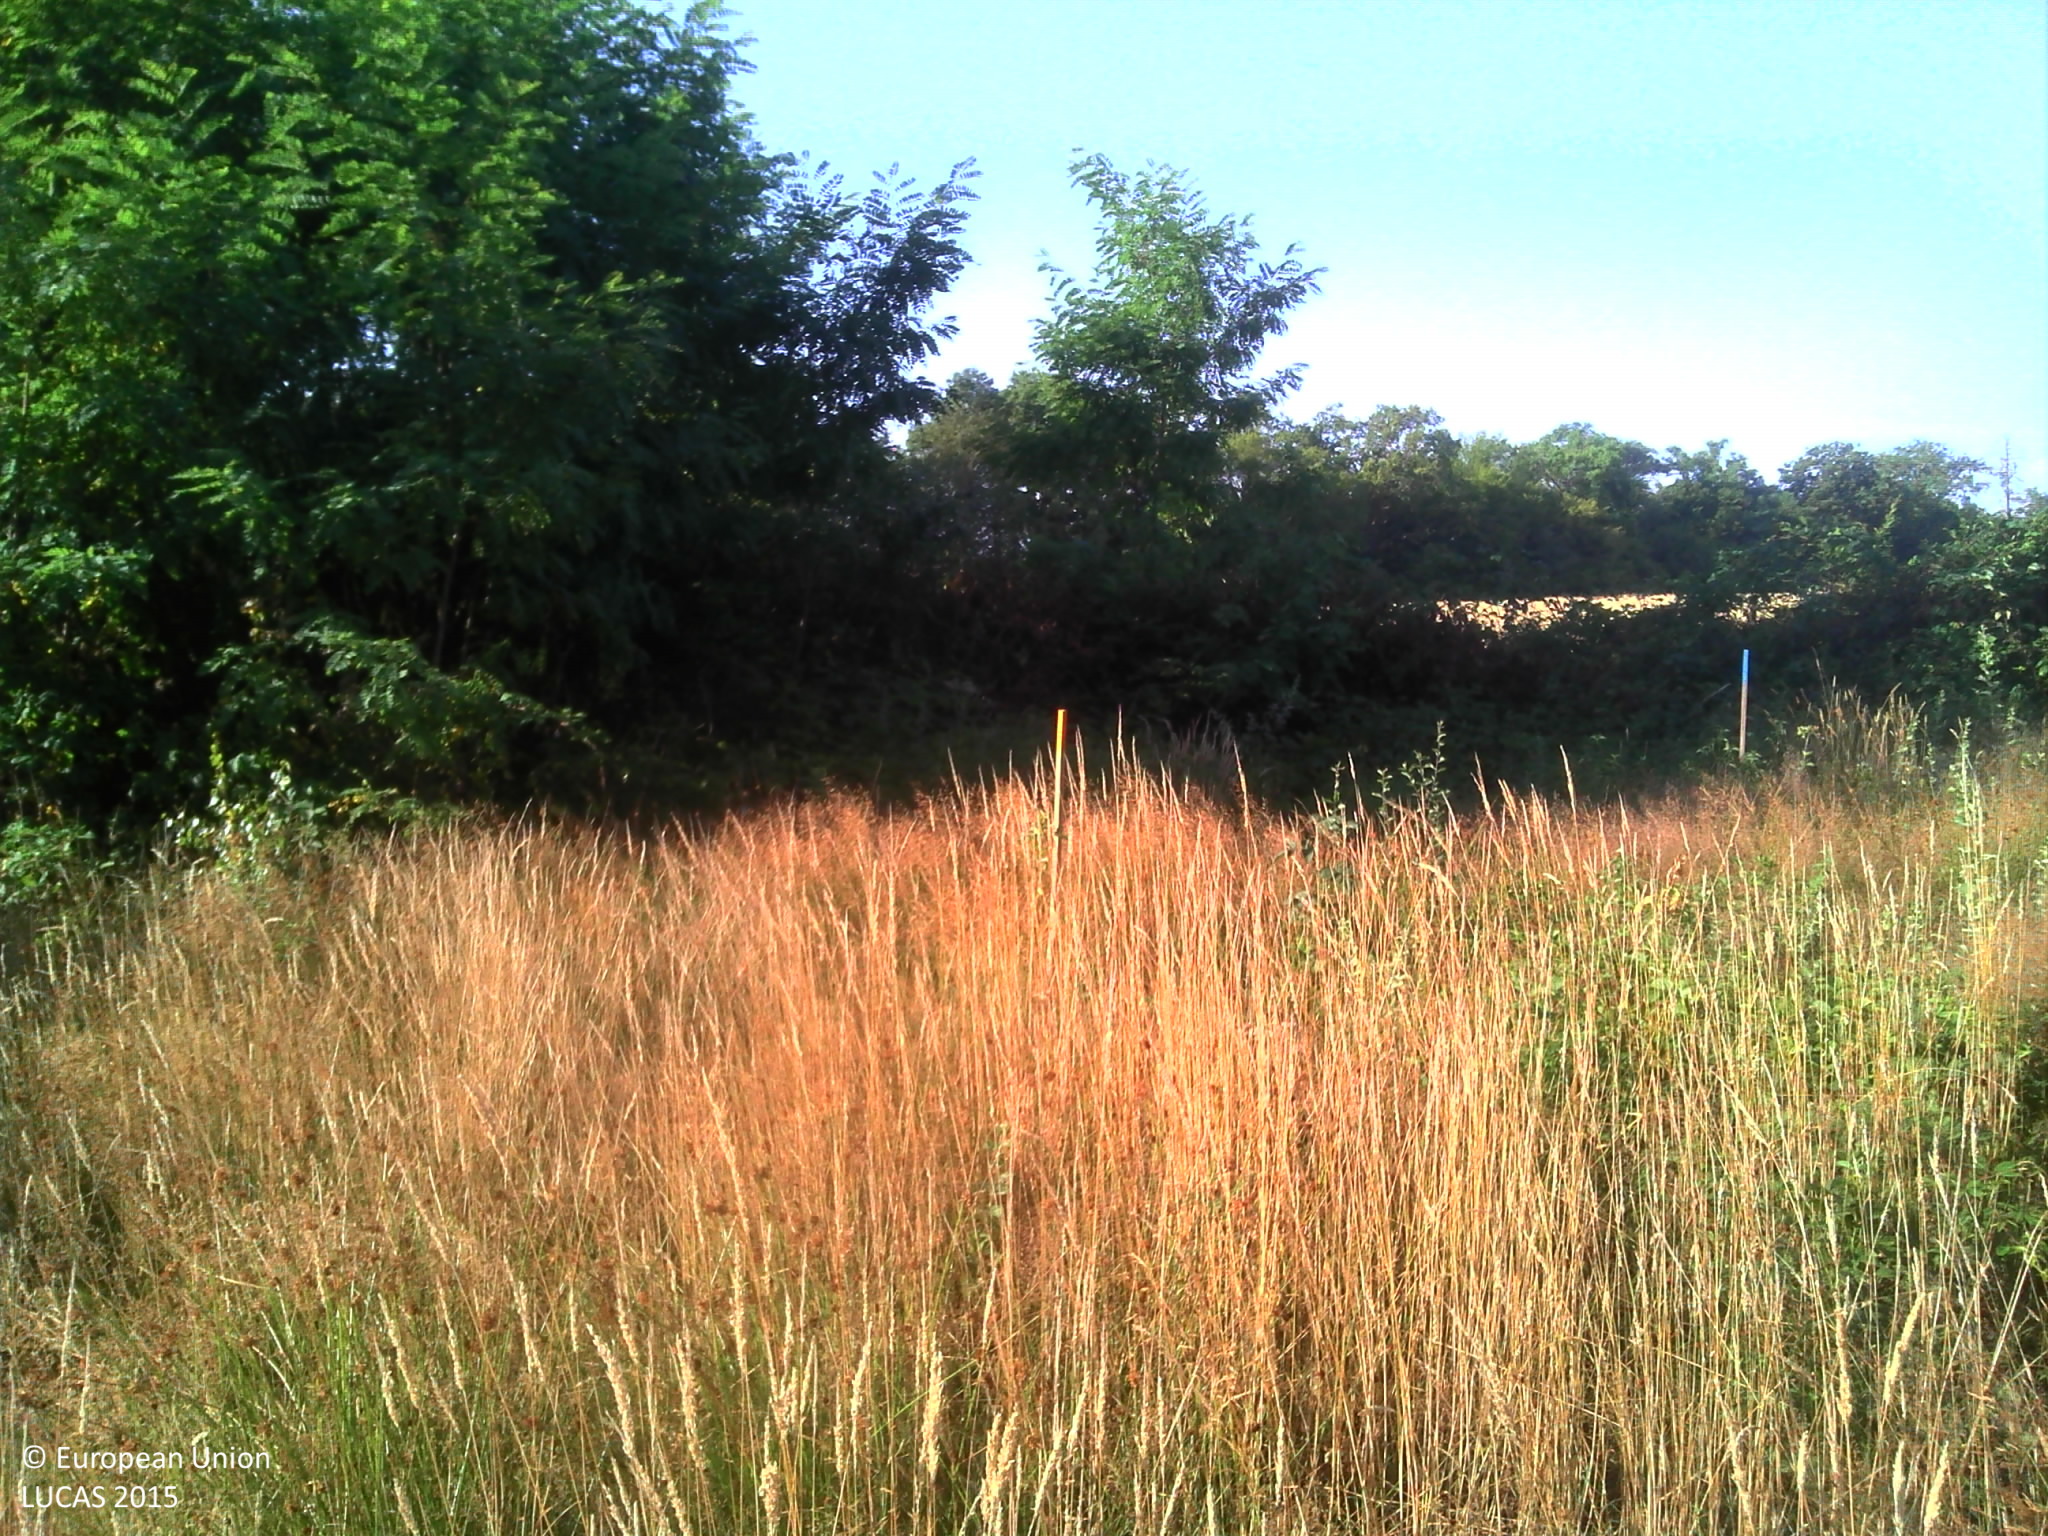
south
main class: Woodland
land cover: Broadleaved woodland
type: mesophytic deciduous forest
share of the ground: > 75 %
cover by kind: broadleaved forest trees 90 %, shrubs 10 %
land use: Forestry
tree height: > 5 m
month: July
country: FR
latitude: 46.7989
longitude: 5.1145
